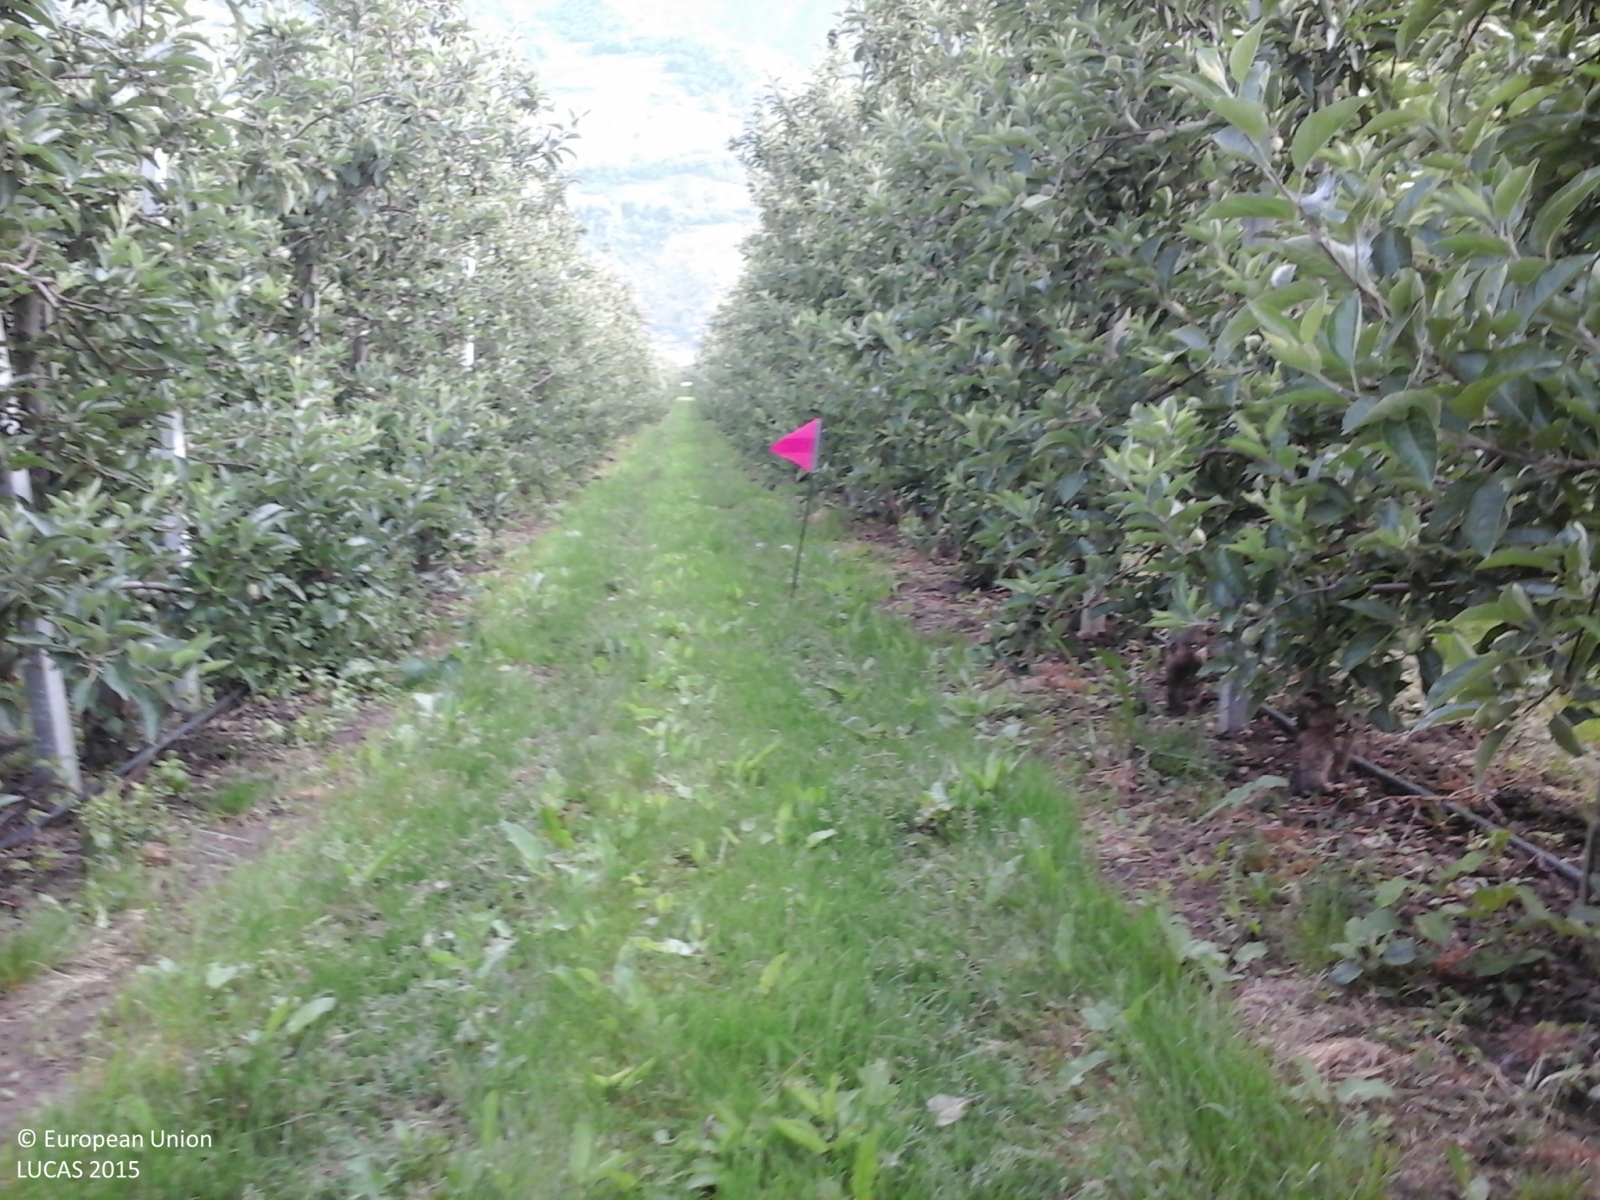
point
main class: Cropland
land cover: Apple fruit
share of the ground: > 75 %
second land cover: Grassland without tree/shrub cover
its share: > 75 %
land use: Agriculture (excluding fallow land and kitchen gardens)
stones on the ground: < 10 %
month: June
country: IT
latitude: 46.6349
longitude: 10.9785
